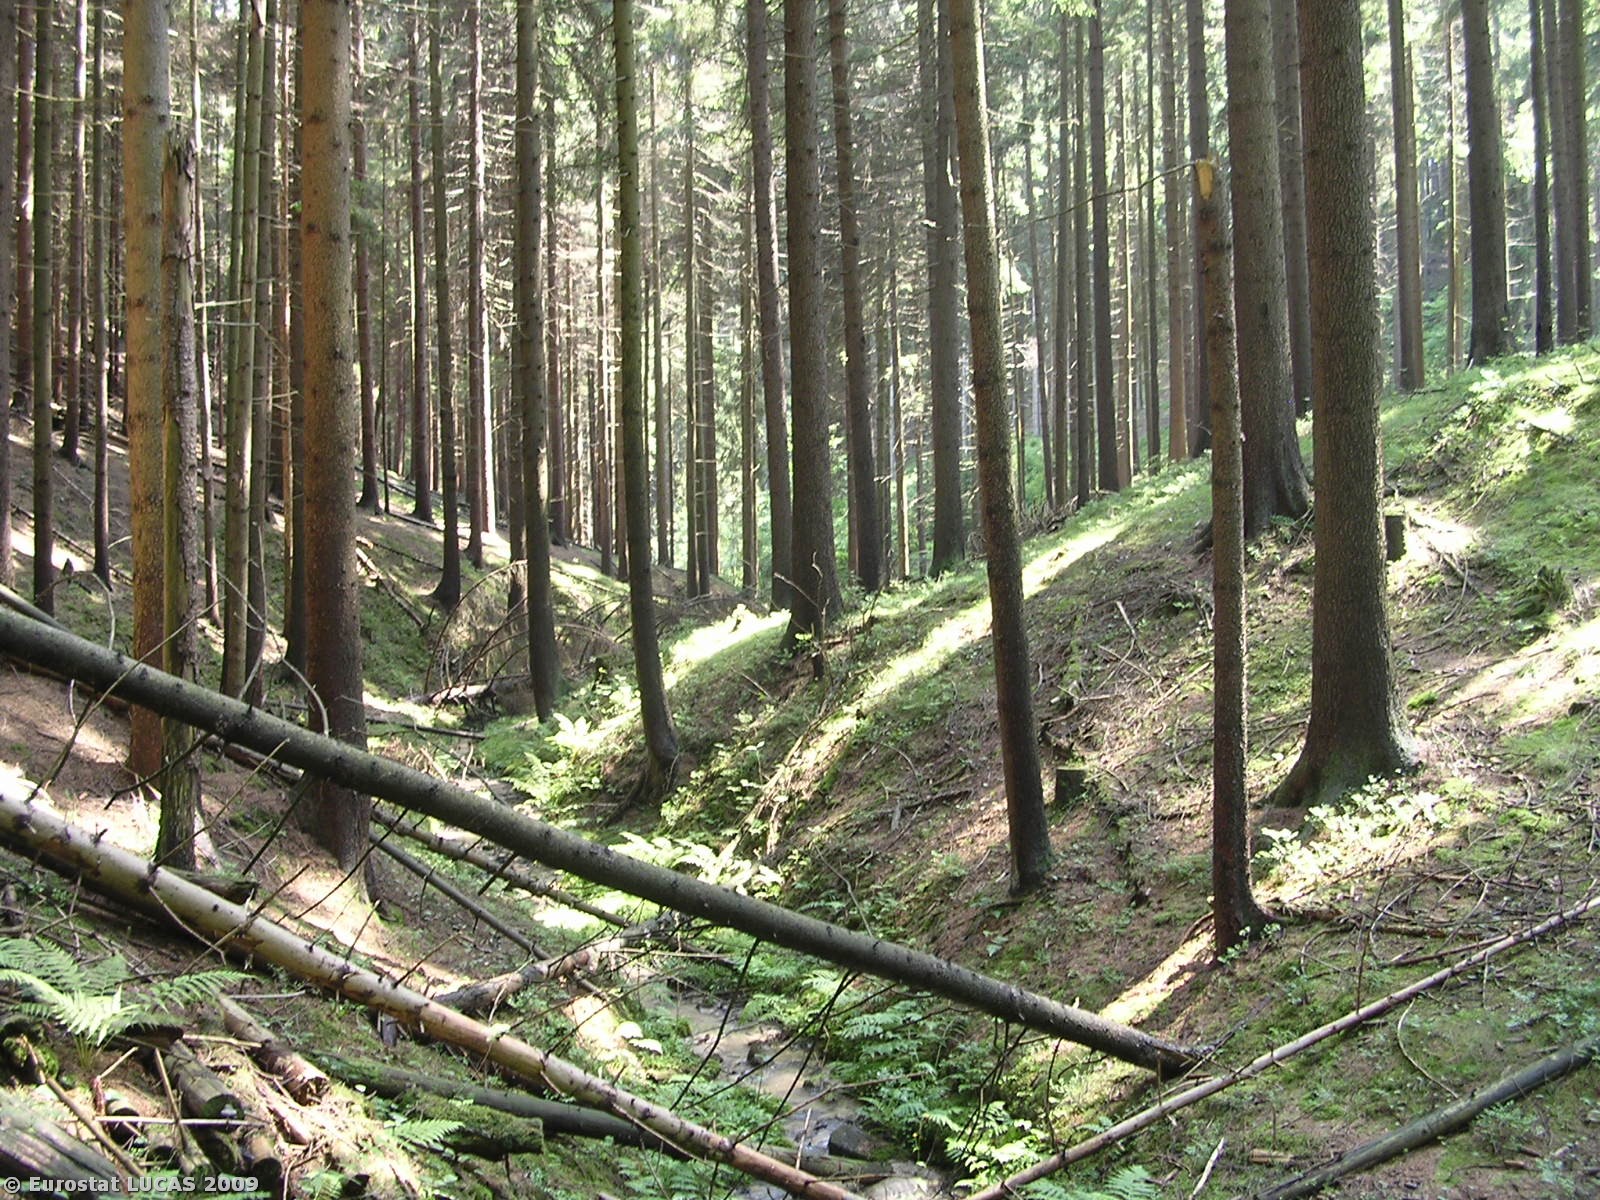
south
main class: Woodland
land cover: Coniferous woodland
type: hemiboreal forest and nemoral coniferous forest and mixed broadleaved-coniferous forest
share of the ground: > 75 %
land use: Forestry
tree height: > 5 m
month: July
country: CZ
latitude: 50.6705
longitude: 14.9693
